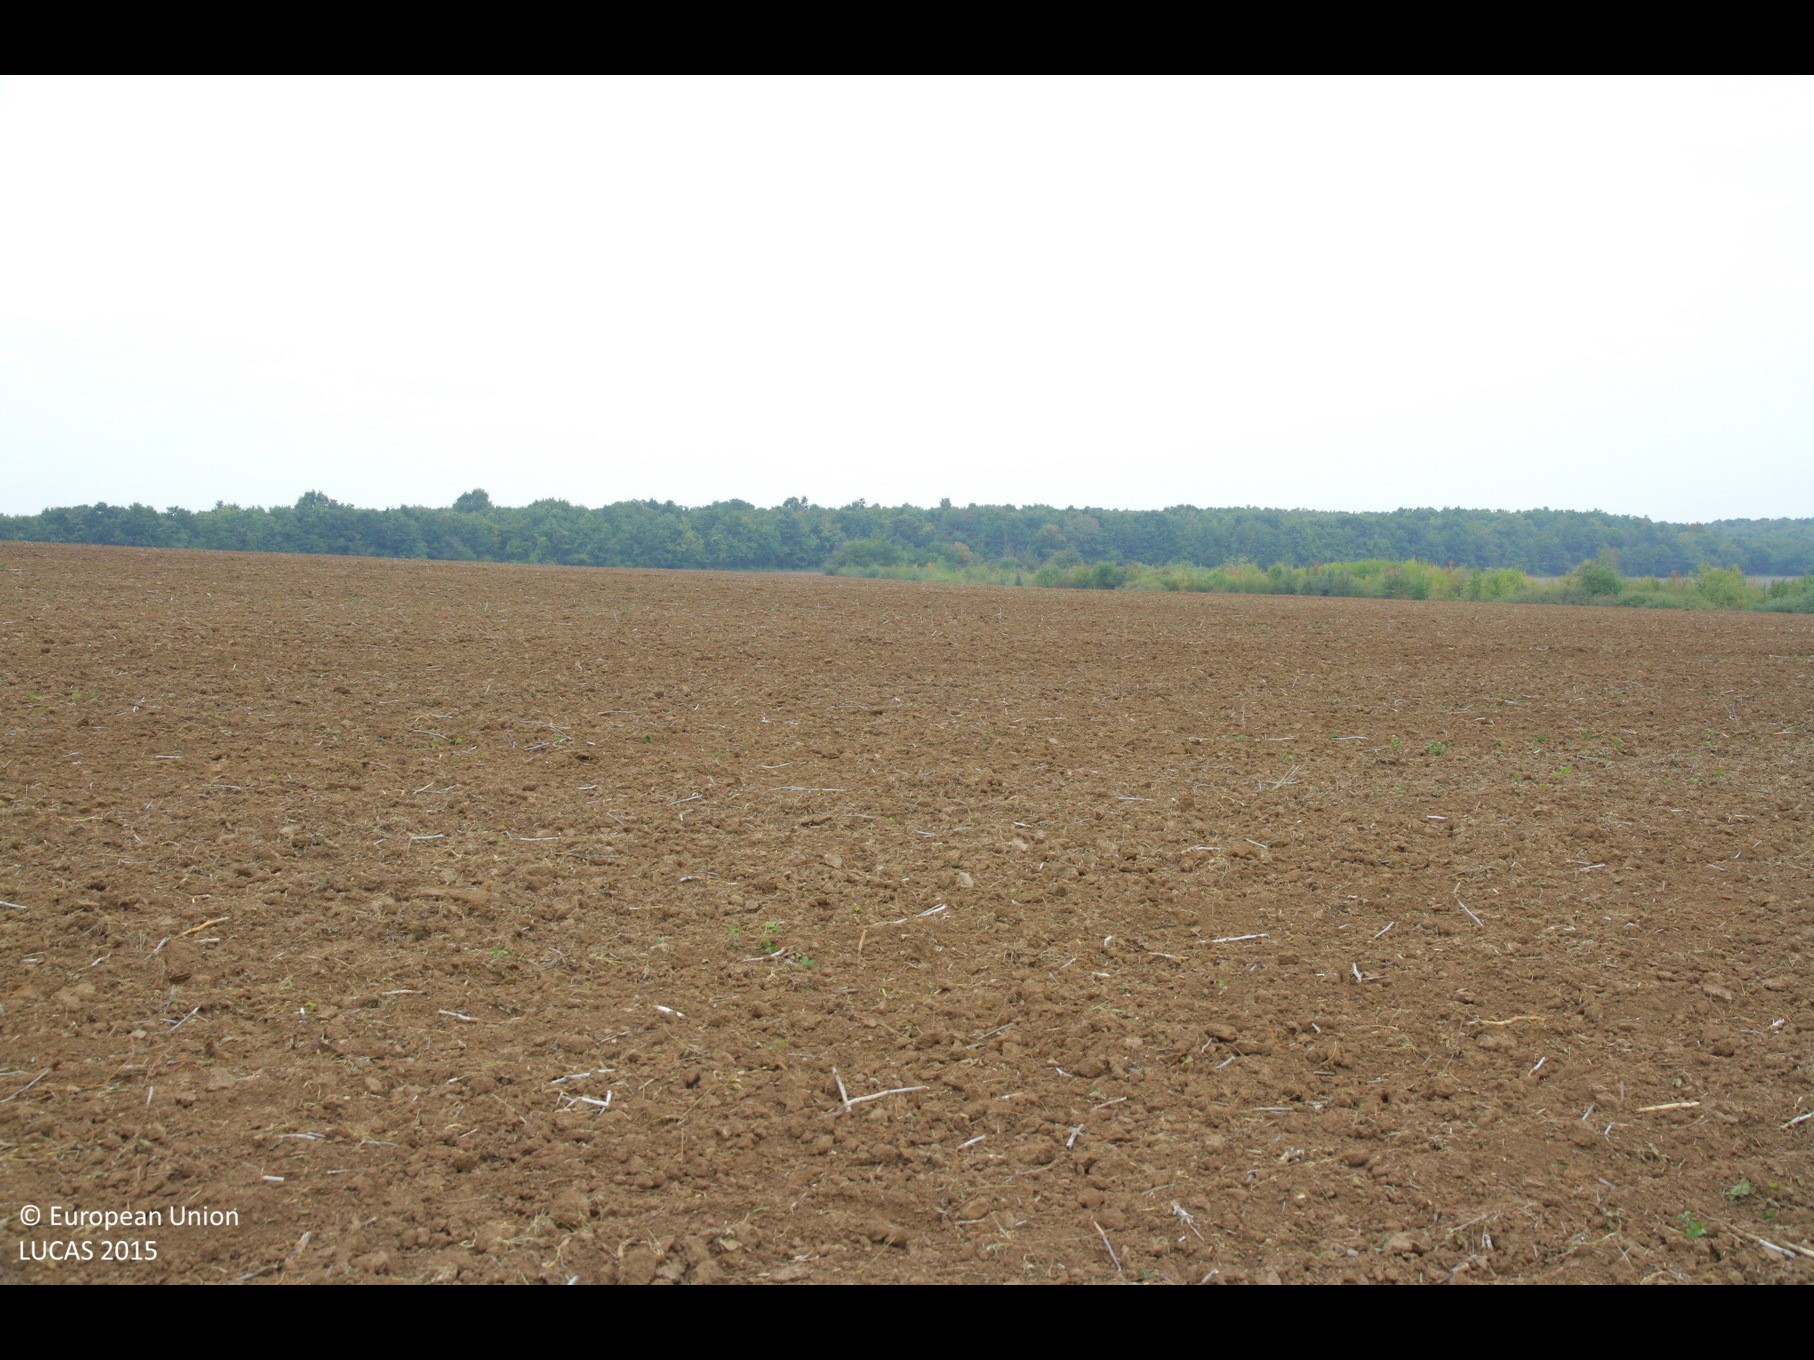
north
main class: Cropland
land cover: Rape and turnip rape
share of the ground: < 10 %
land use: Agriculture (excluding fallow land and kitchen gardens)
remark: Harvested field
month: October
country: BG
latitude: 43.5015
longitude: 27.0249
